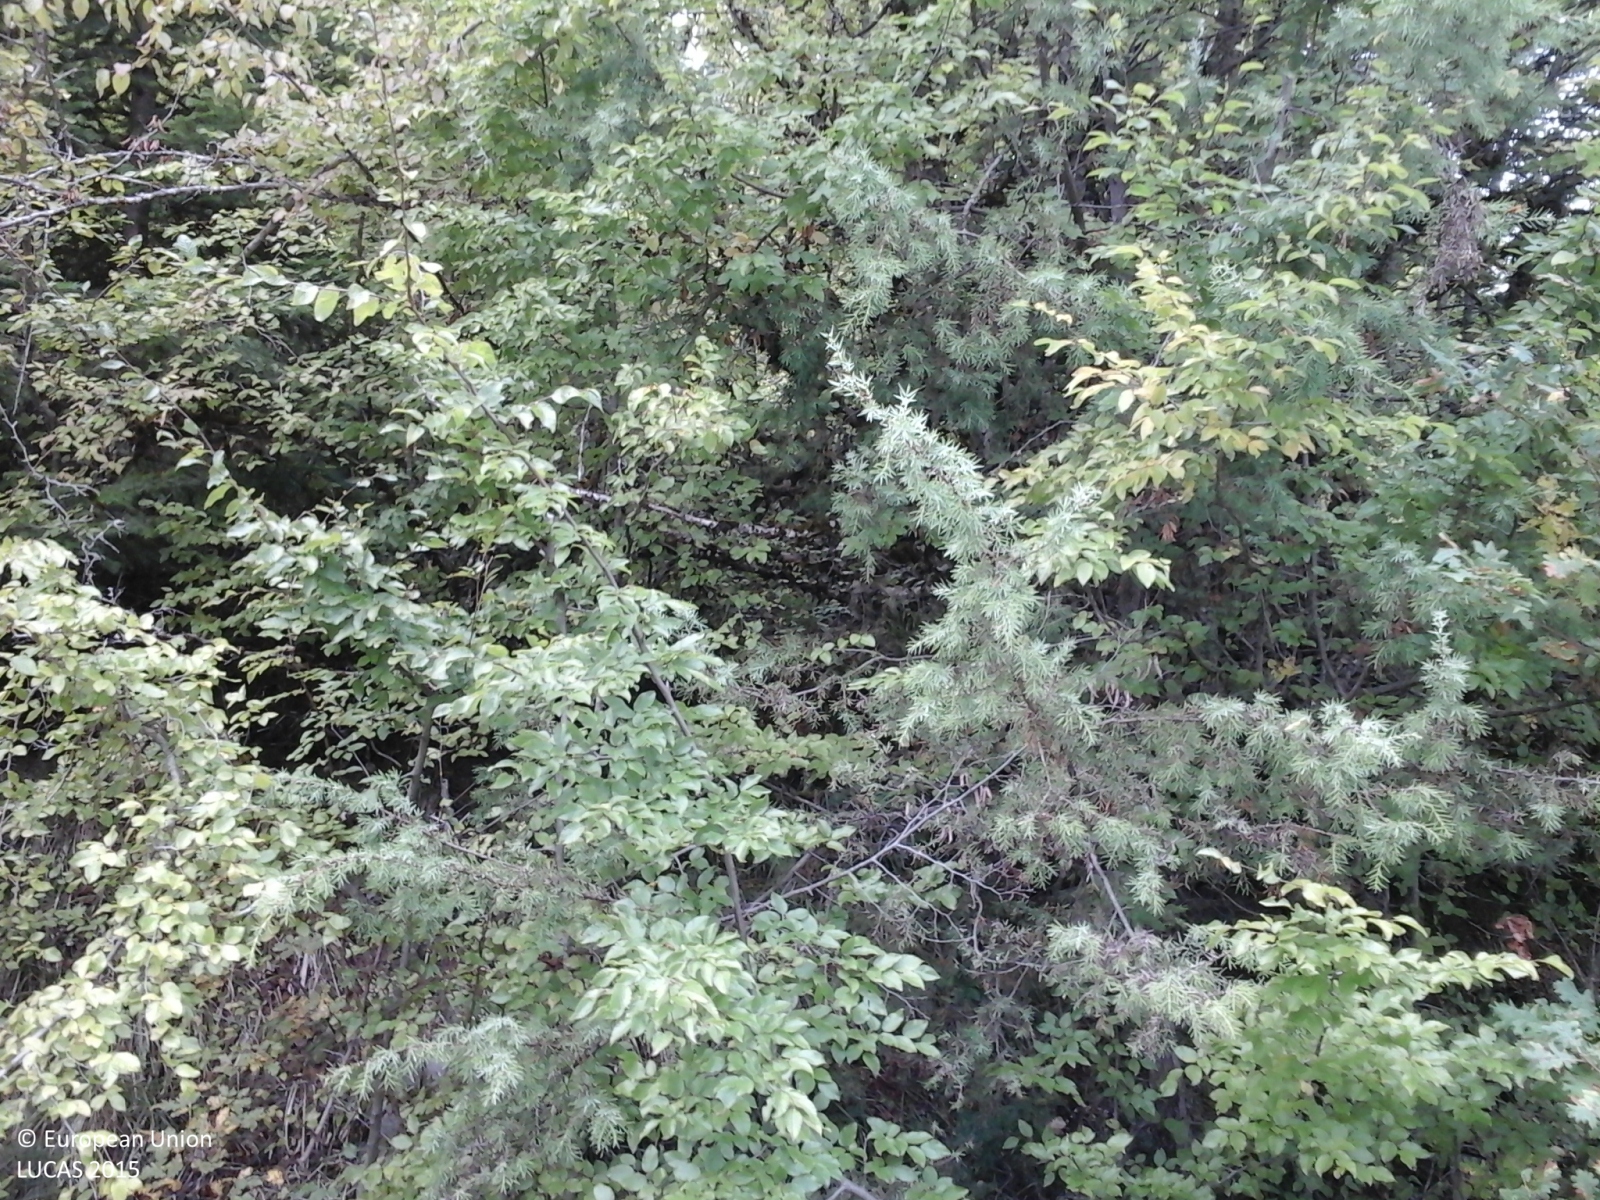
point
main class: Woodland
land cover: Broadleaved woodland
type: thermophilous deciduous forest
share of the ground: > 75 %
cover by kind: broadleaved forest trees 90 %, shrubs 5 %, herbaceous plants 5 %
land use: Forestry
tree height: > 5 m
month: October
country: GR
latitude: 40.2567
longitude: 20.7655
